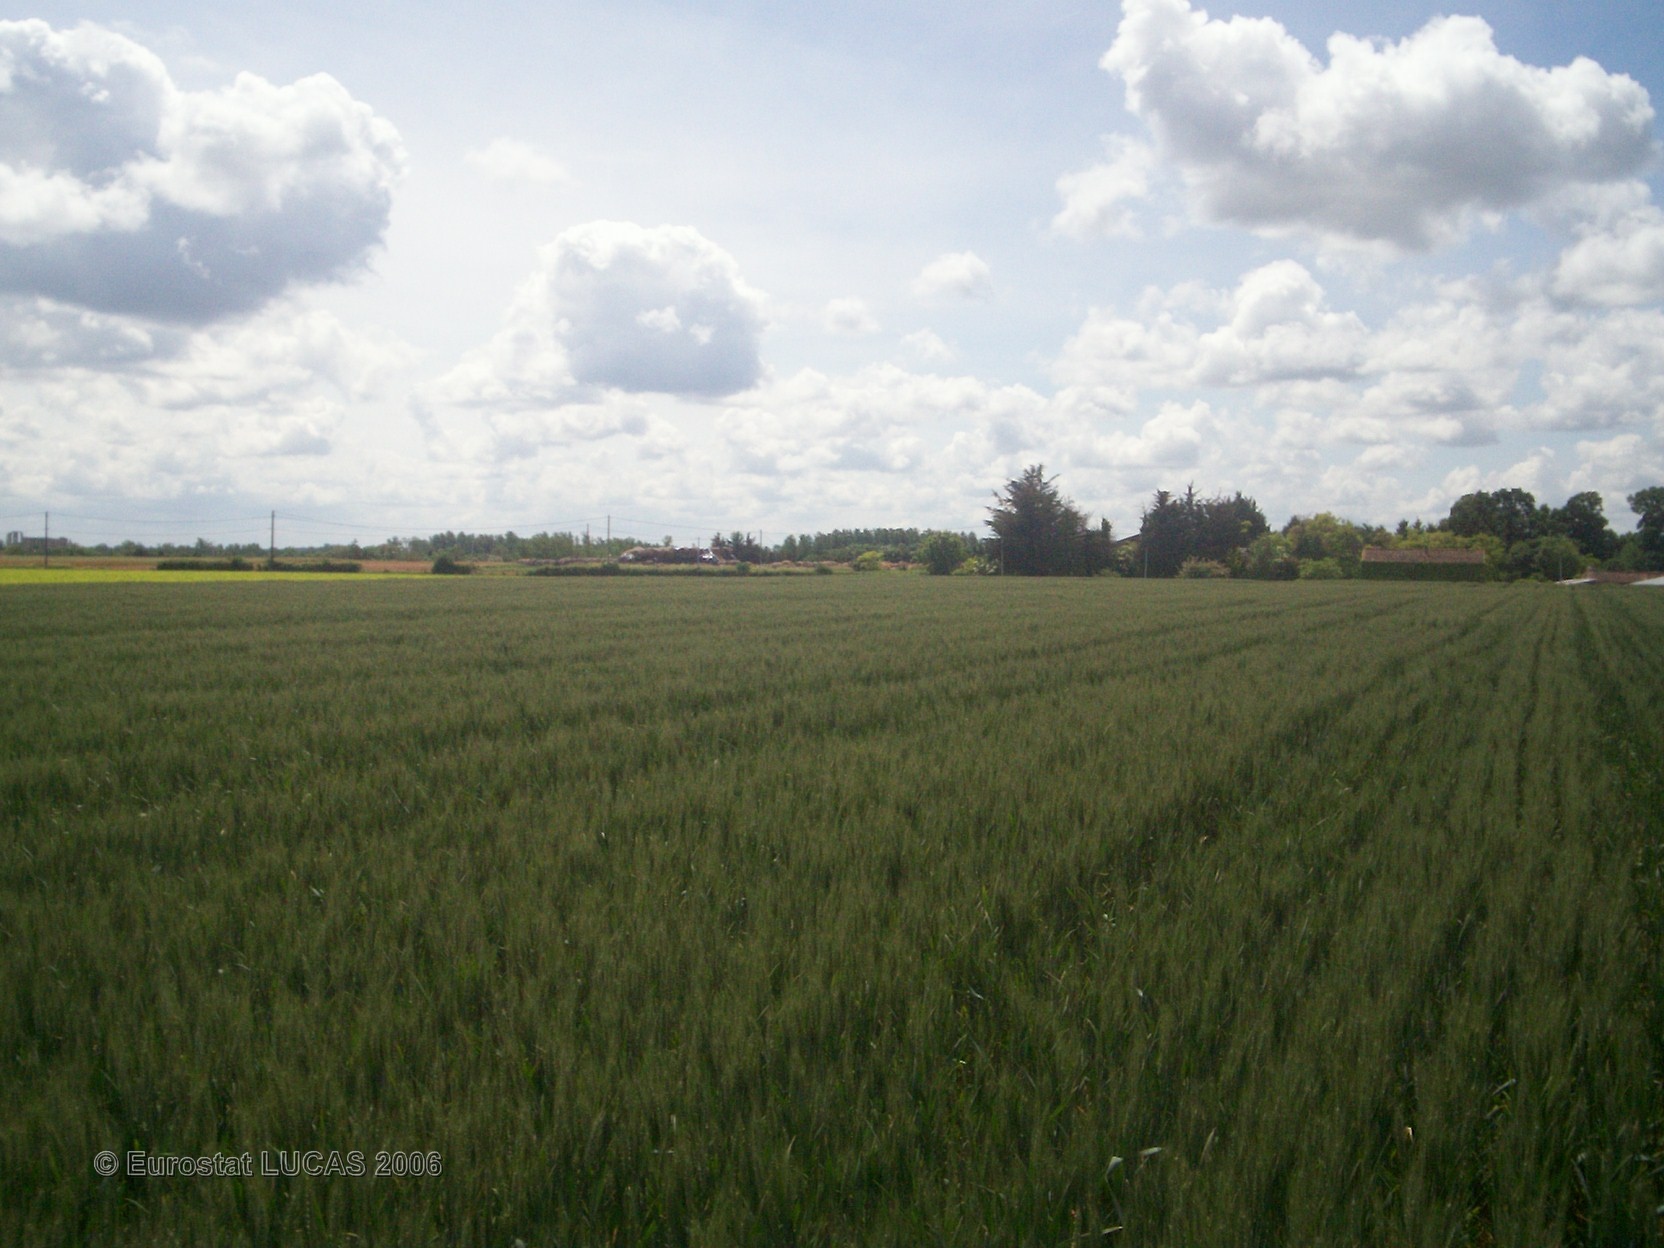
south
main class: Cropland
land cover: Common wheat
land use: Agriculture (excluding fallow land and kitchen gardens)
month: May
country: FR
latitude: 46.3884
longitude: -0.7567
